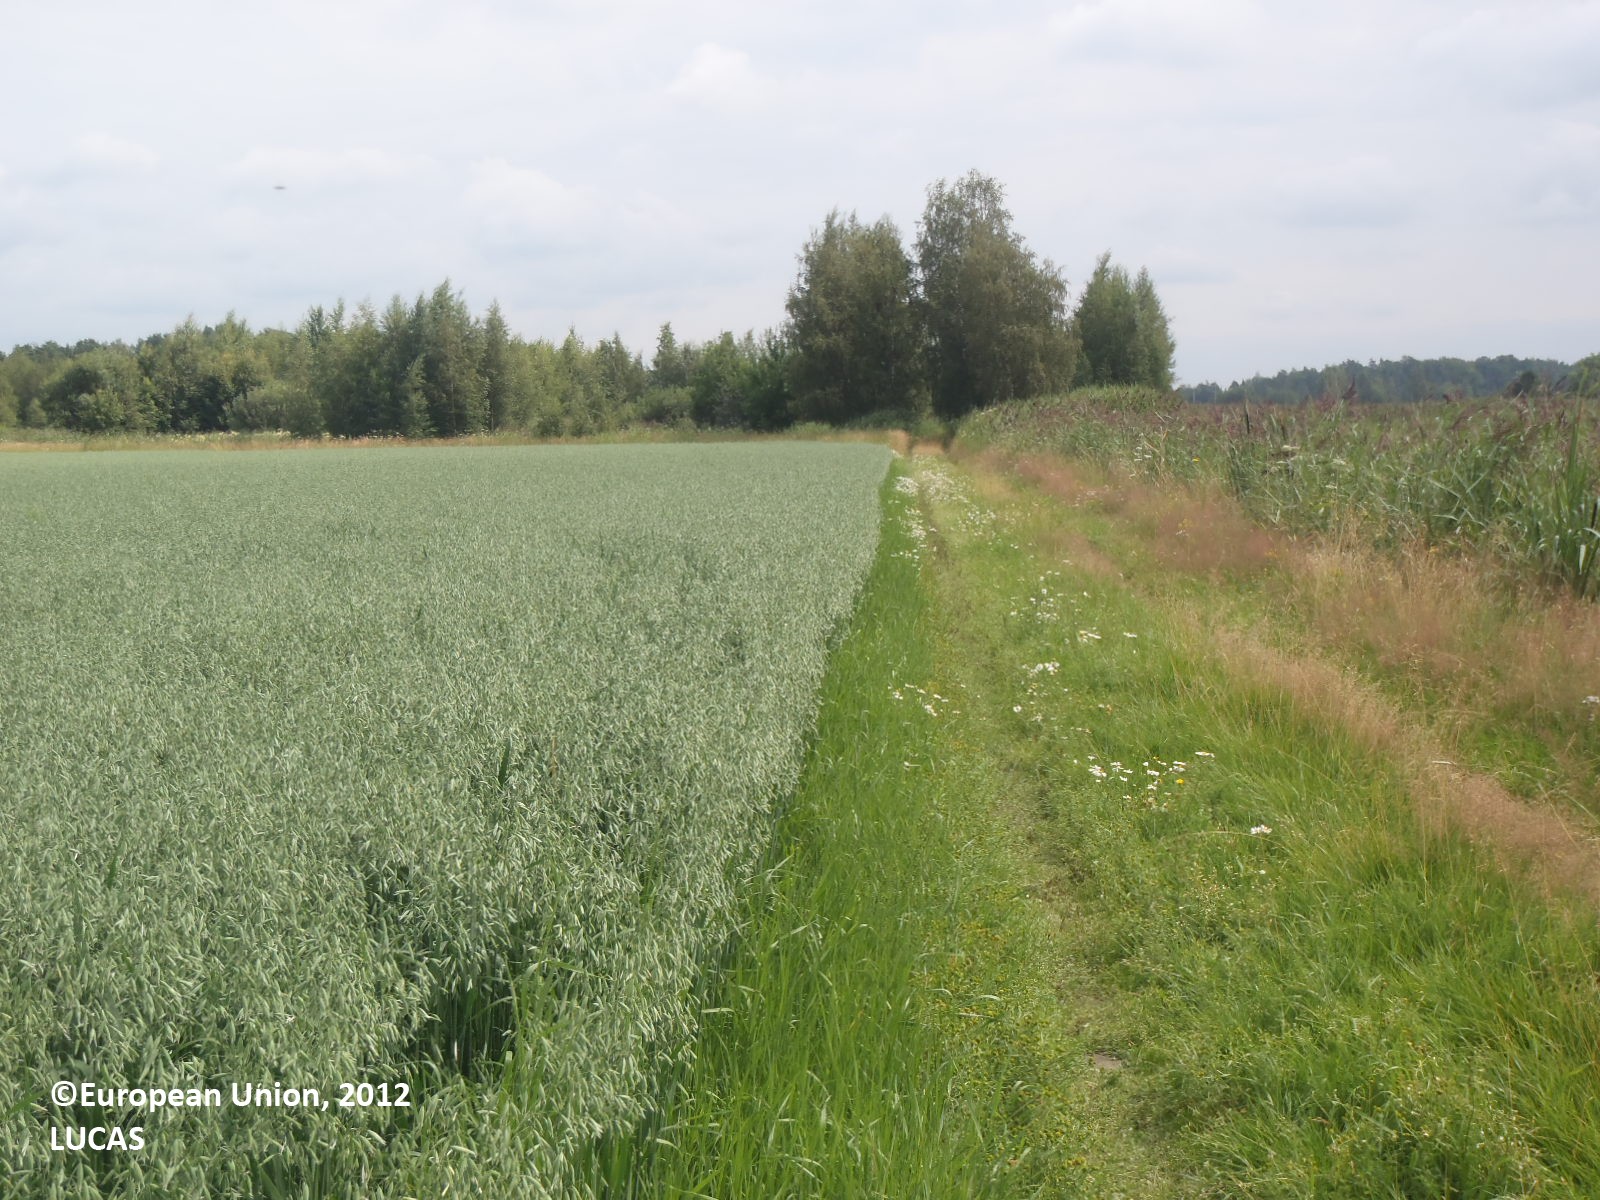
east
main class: Cropland
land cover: Oats
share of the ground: > 75 %
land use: Agriculture (excluding fallow land and kitchen gardens)
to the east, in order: Oats; Grassland with sparse tree/shrub cover; Ditches and canals; Abandoned hedges; Arable land (only in case pi); Ditches and canals; Arable land (only in case pi)
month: July
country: FI
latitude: 60.5446
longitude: 21.9670
